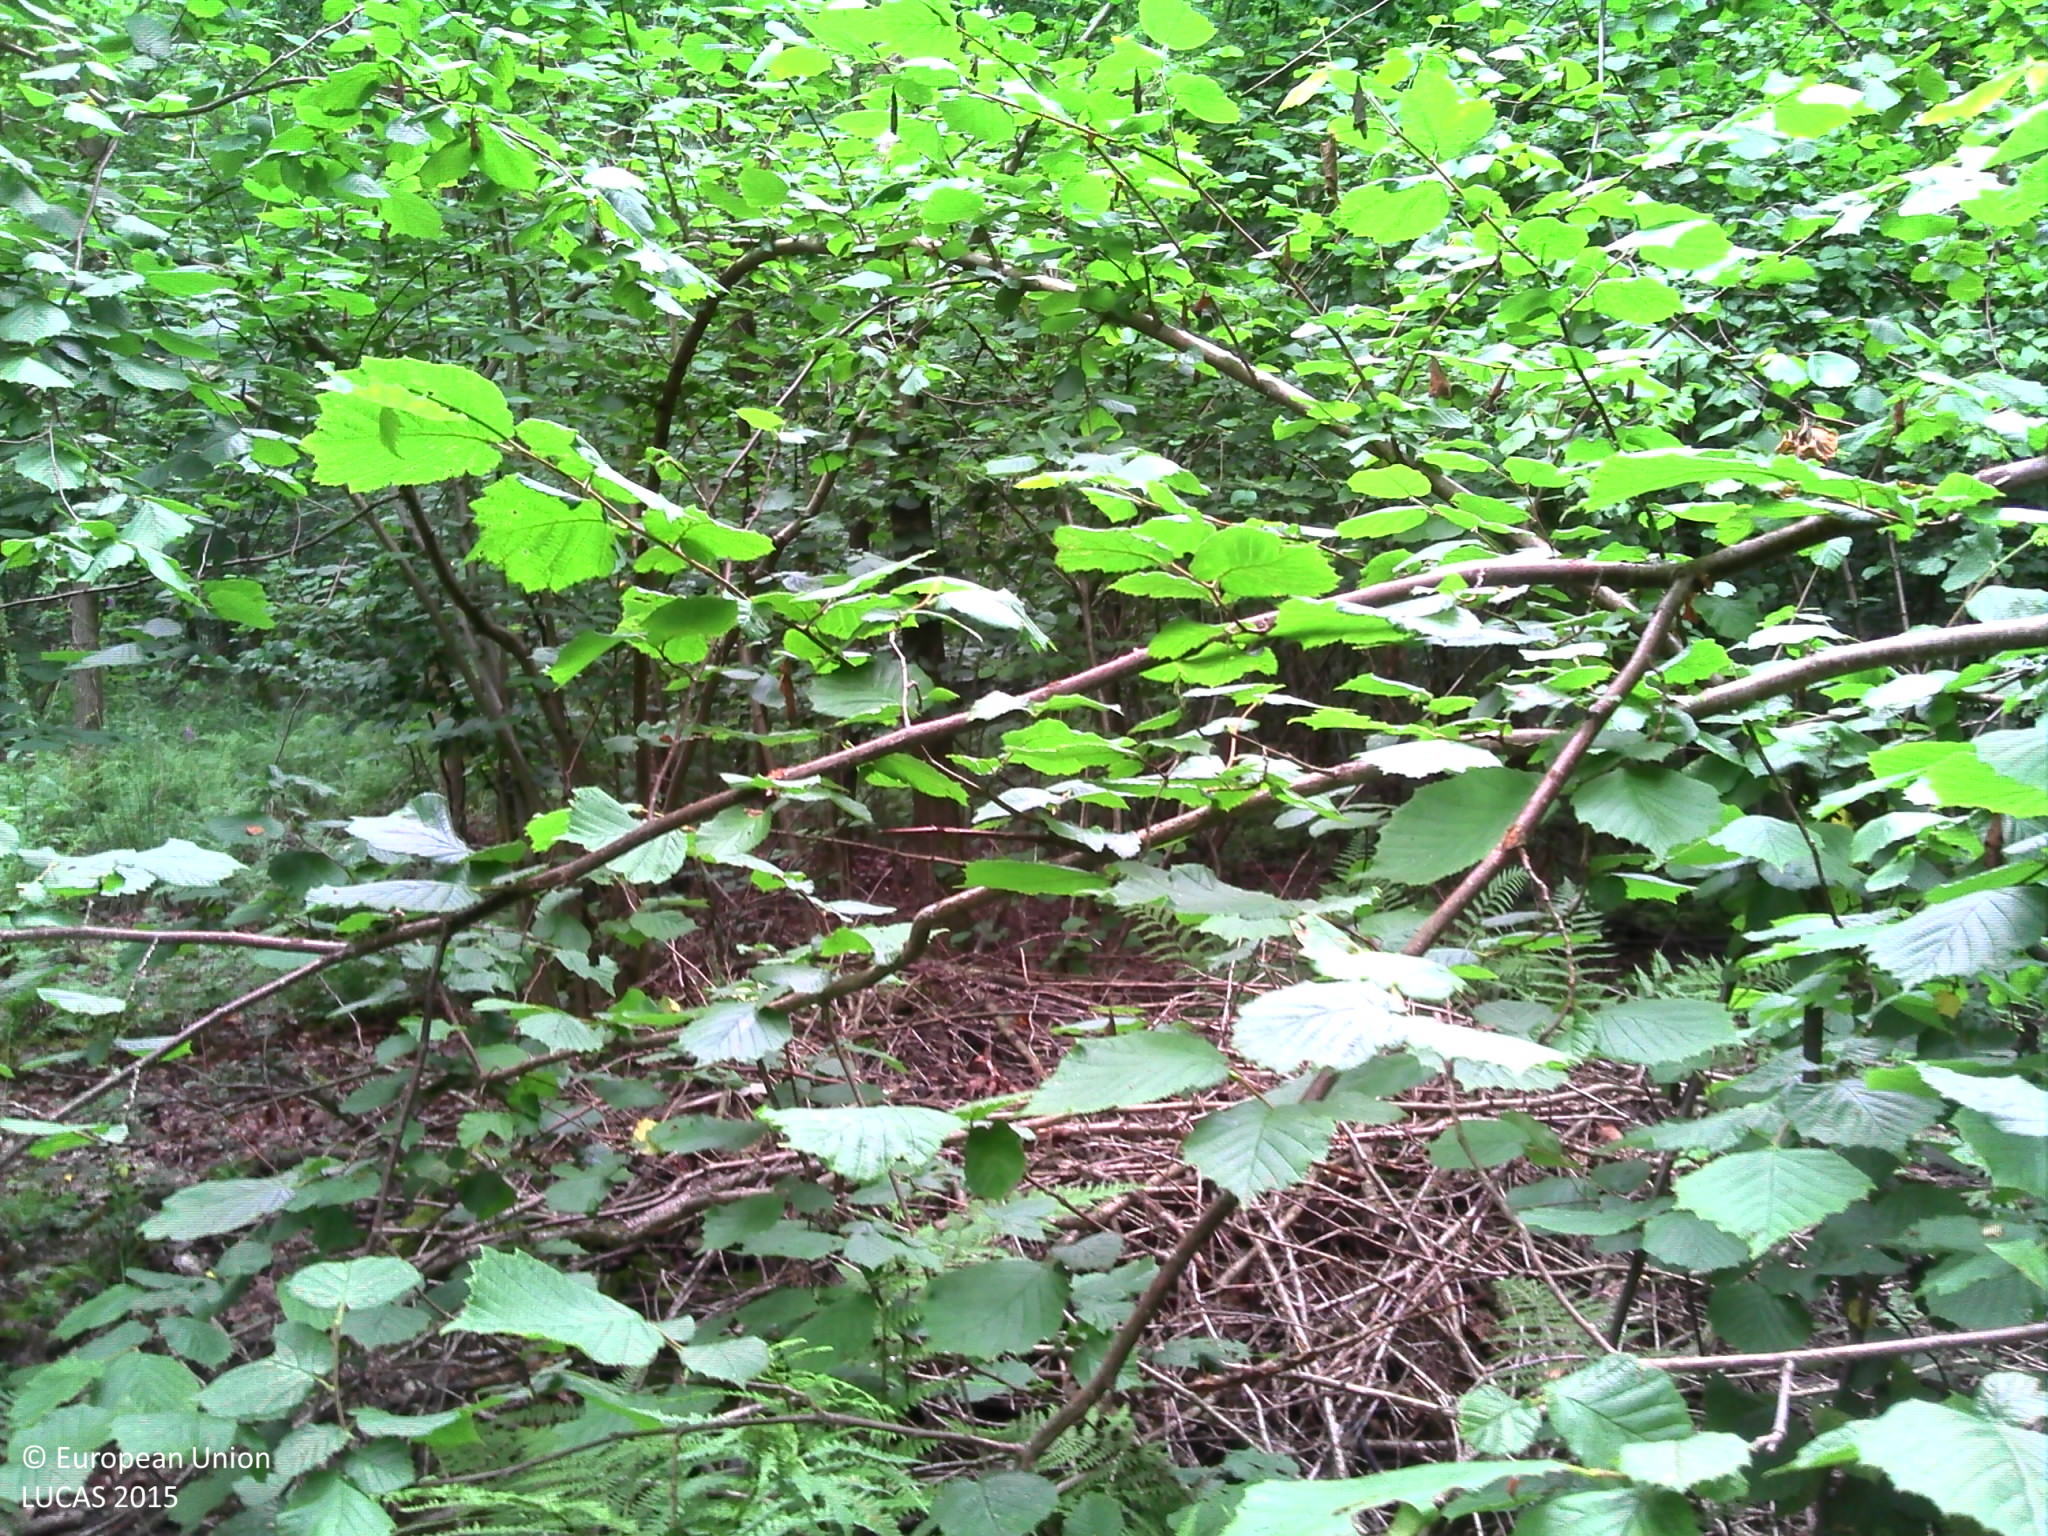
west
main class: Woodland
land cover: Broadleaved woodland
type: mesophytic deciduous forest
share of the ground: > 75 %
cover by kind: broadleaved forest trees 75 %, herbaceous plants 15 %, shrubs 10 %
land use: Forestry
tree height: > 5 m
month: July
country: BE
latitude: 50.2199
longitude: 4.6284
